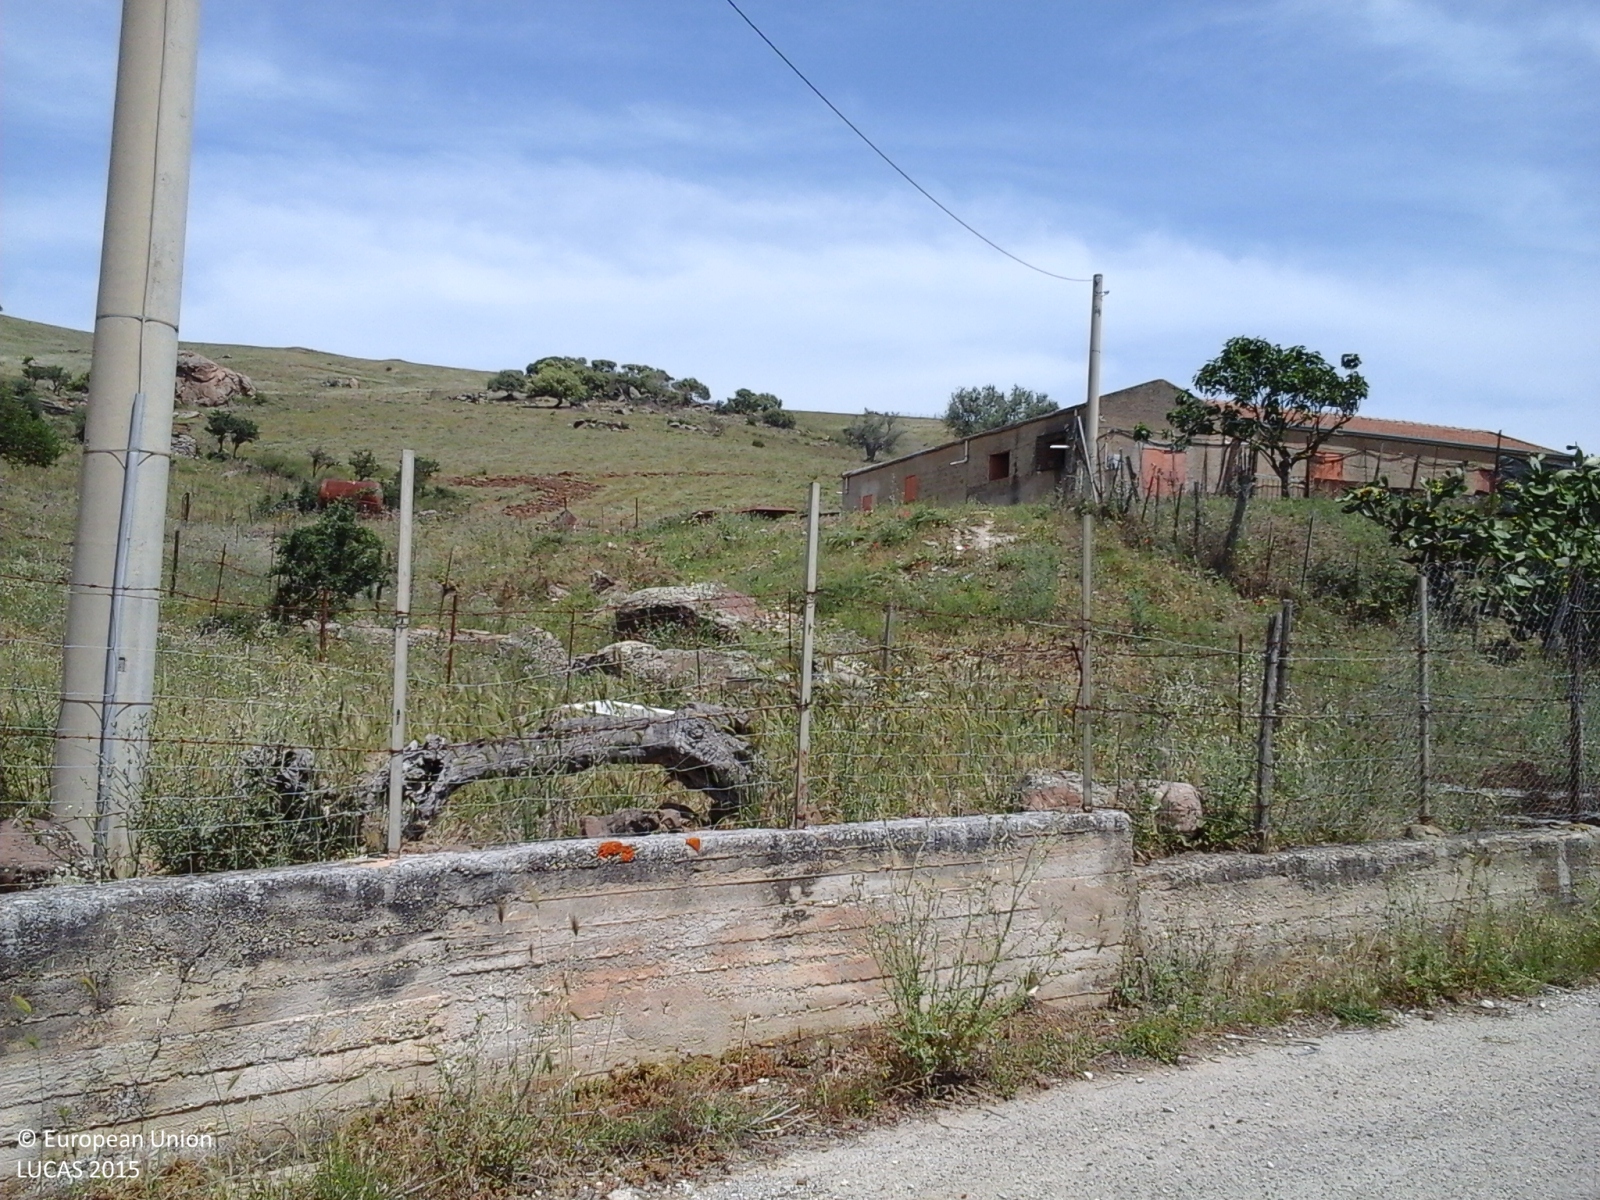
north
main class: Grassland
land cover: Grassland without tree/shrub cover
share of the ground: > 75 %
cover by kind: herbaceous plants 100 %
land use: Agriculture (excluding fallow land and kitchen gardens)
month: May
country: IT
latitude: 37.9559
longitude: 13.4919
